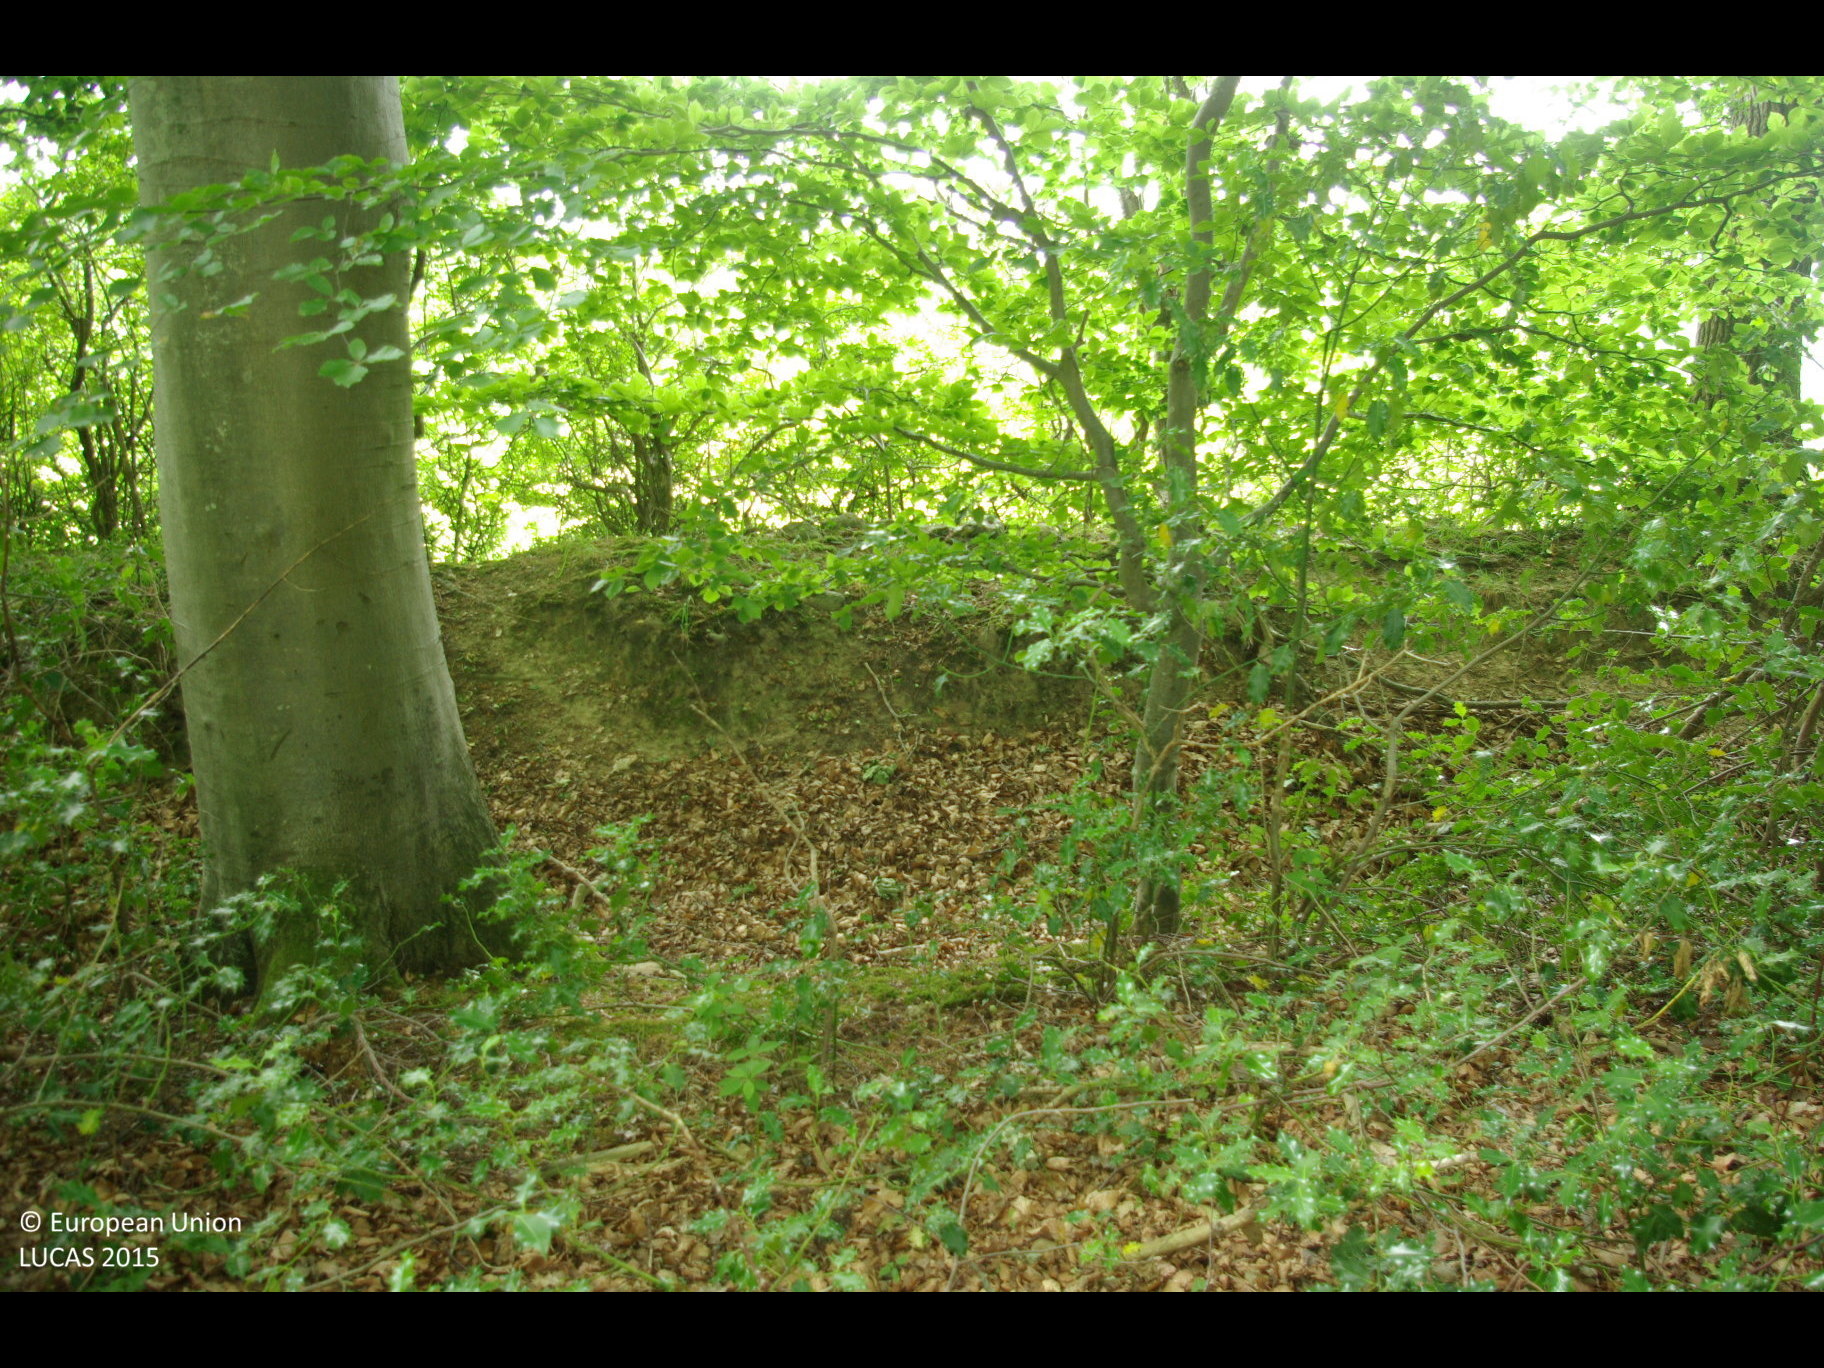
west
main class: Woodland
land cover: Broadleaved woodland
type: beech forest
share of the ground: > 75 %
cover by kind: broadleaved forest trees 90 %, herbaceous plants 10 %
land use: Semi-natural and natural areas not in use
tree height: > 5 m
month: July
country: DE
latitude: 54.6959
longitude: 9.9535
